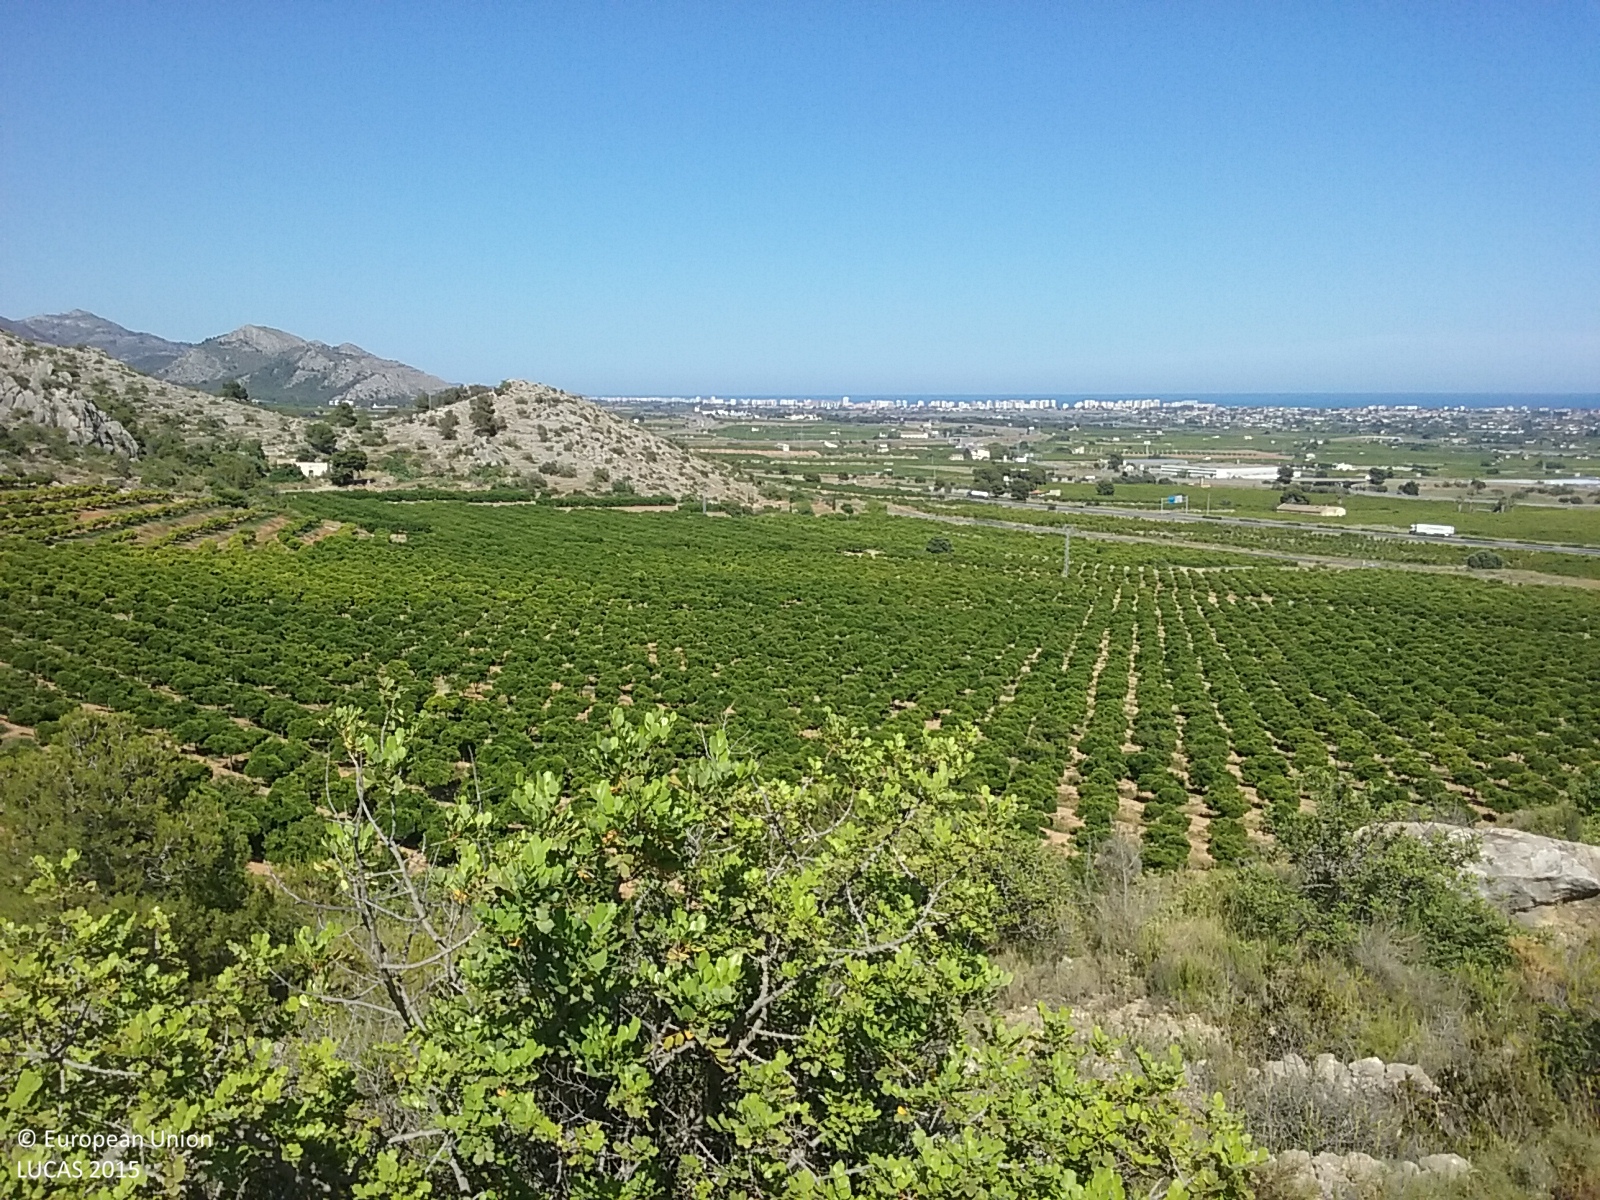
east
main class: Cropland
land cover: Permanent industrial crops
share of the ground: < 10 %
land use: Abandoned areas
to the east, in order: Permanent industrial crops; Shrubland without tree cover; Dry stone walls; Permanent industrial crops; Dry stone walls; Permanent industrial crops; Dry stone walls; Shrubland with sparse tree cover; Dry stone walls; Shrubland with sparse tree cover; Paved roads, cycling and walking lanes; Other citrus fruit; Paved roads, cycling and walking lanes; Other citrus fruit
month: June
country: ES
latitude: 40.0240
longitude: -0.0432
